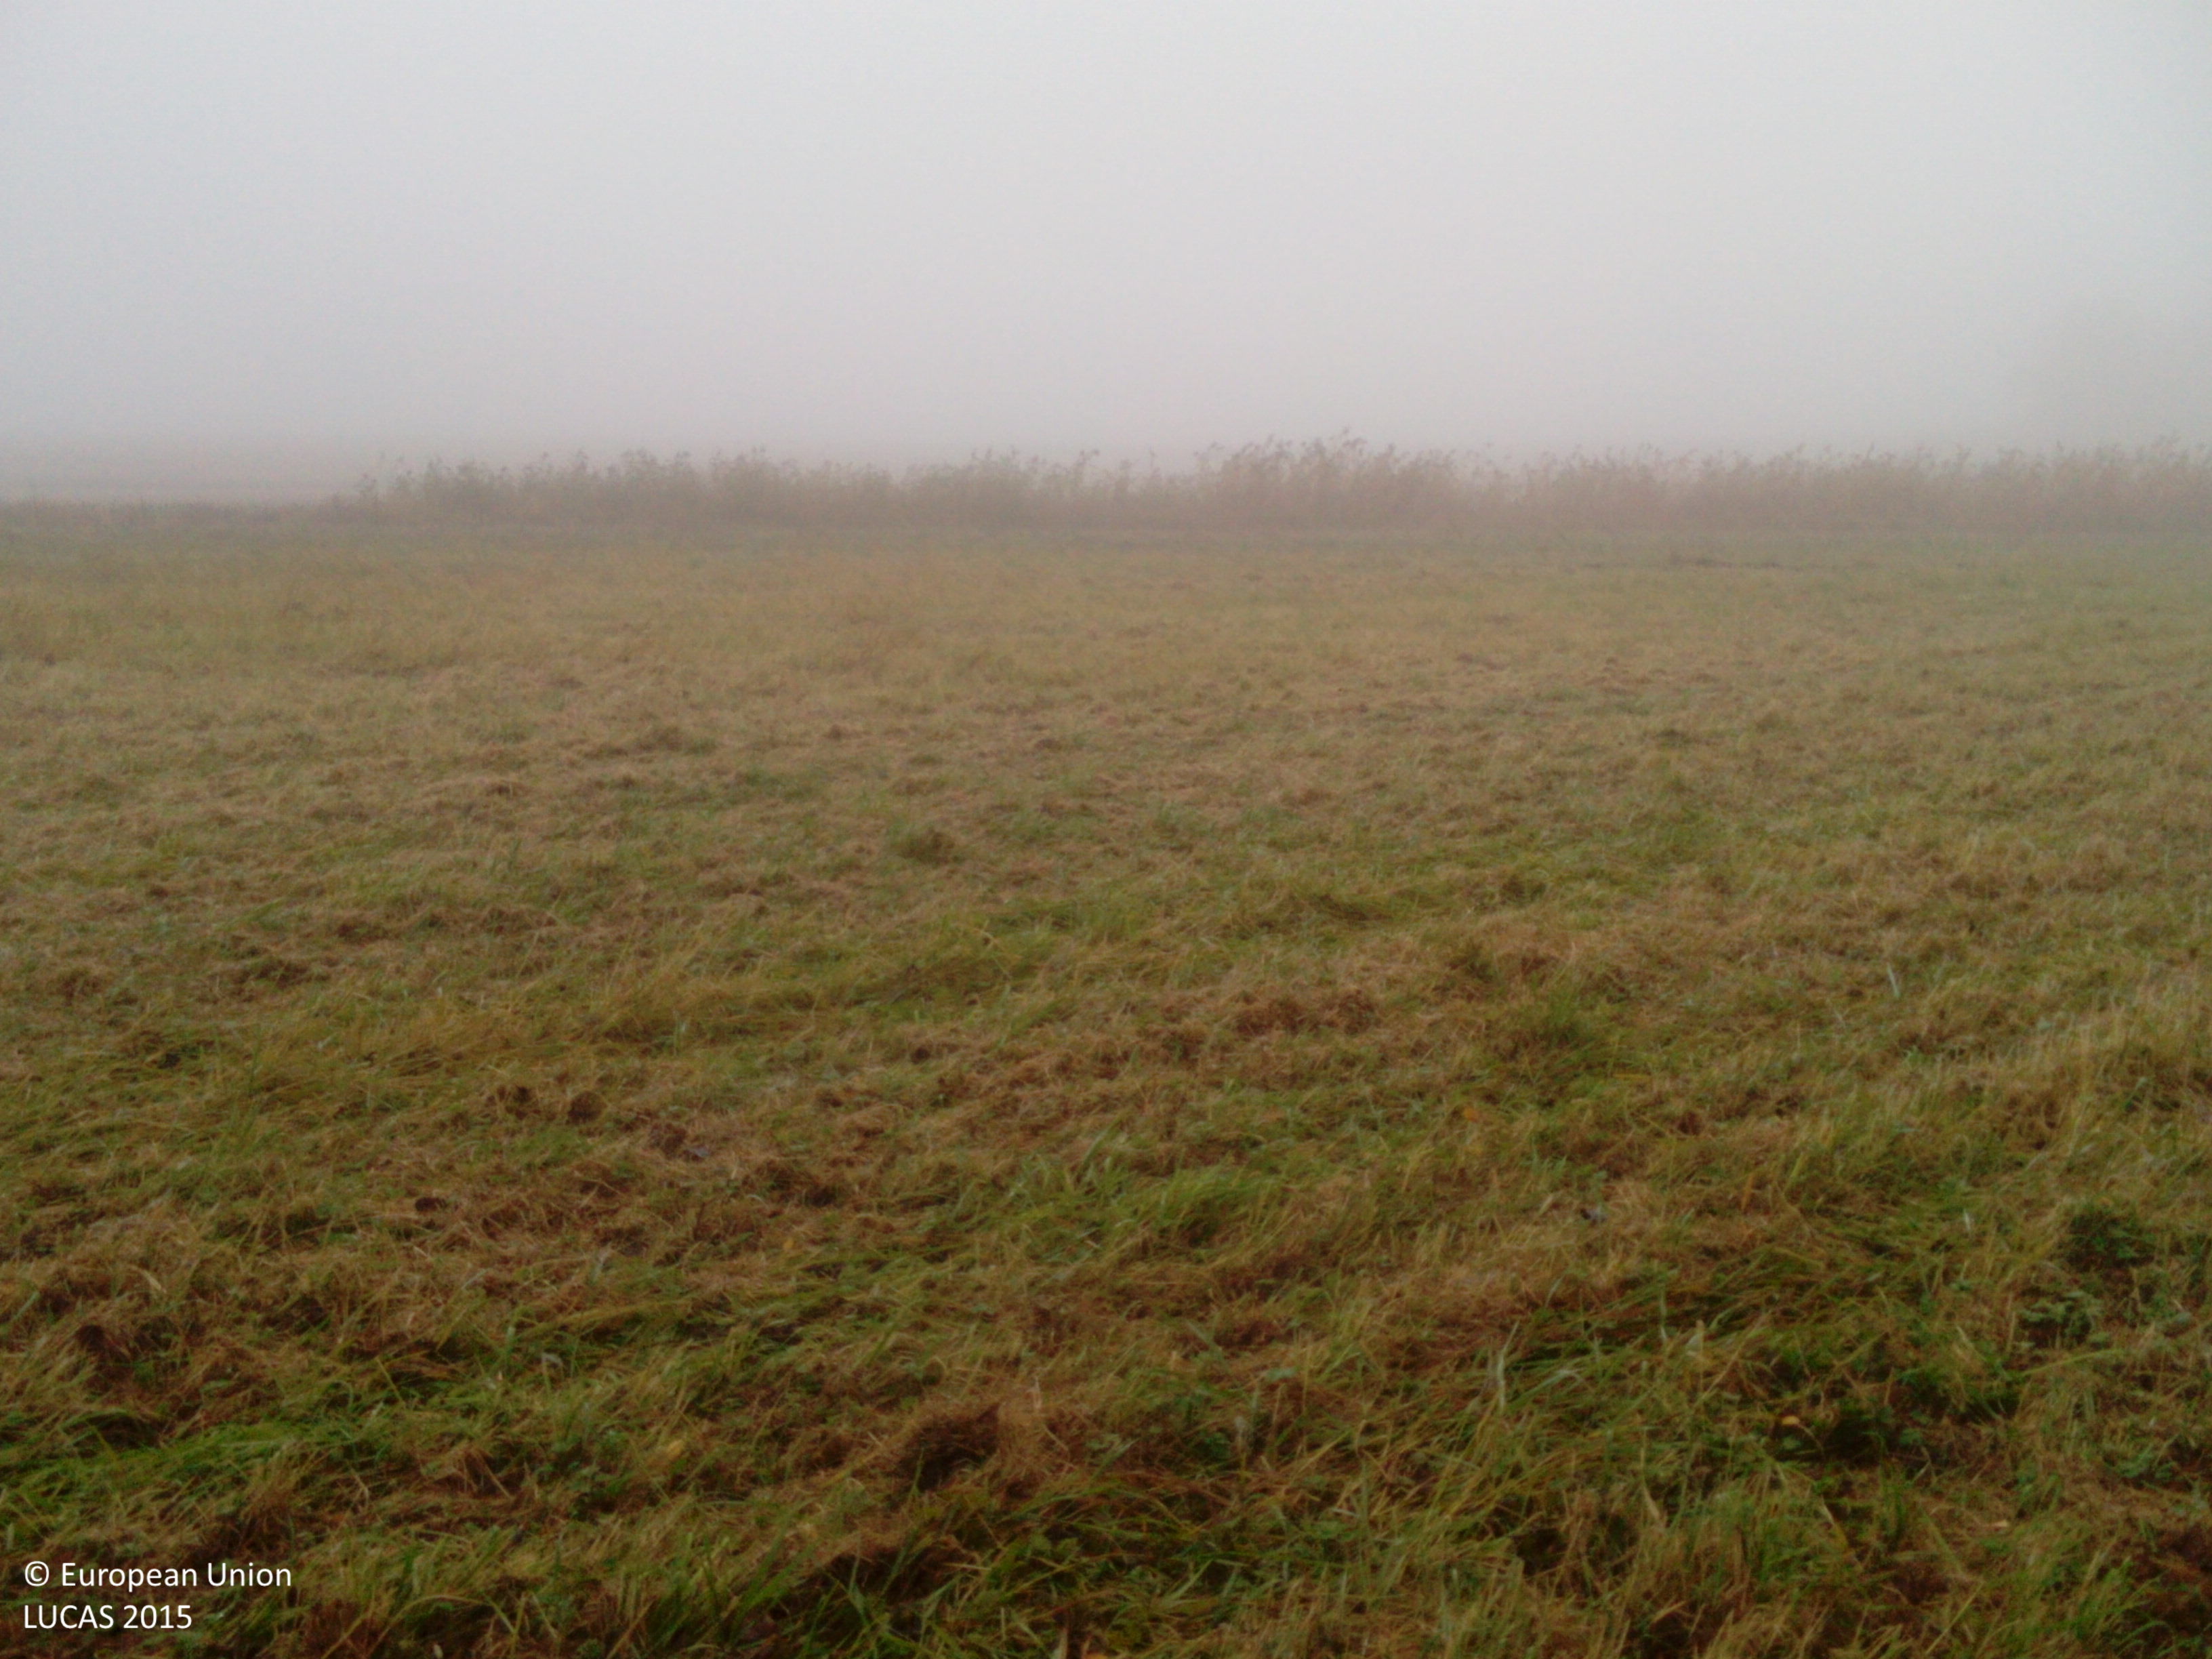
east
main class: Grassland
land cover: Grassland without tree/shrub cover
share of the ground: > 75 %
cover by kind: herbaceous plants 100 %
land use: Agriculture (excluding fallow land and kitchen gardens)
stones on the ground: < 10 %
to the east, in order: Grassland without tree/shrub cover; Shruby margins; Ditches and canals; Grassland without tree/shrub cover; Other bare soil; Common wheat; Ditches and canals; Grass margins; Common wheat; Other bare soil
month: October
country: SE
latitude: 58.8273
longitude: 16.7334
